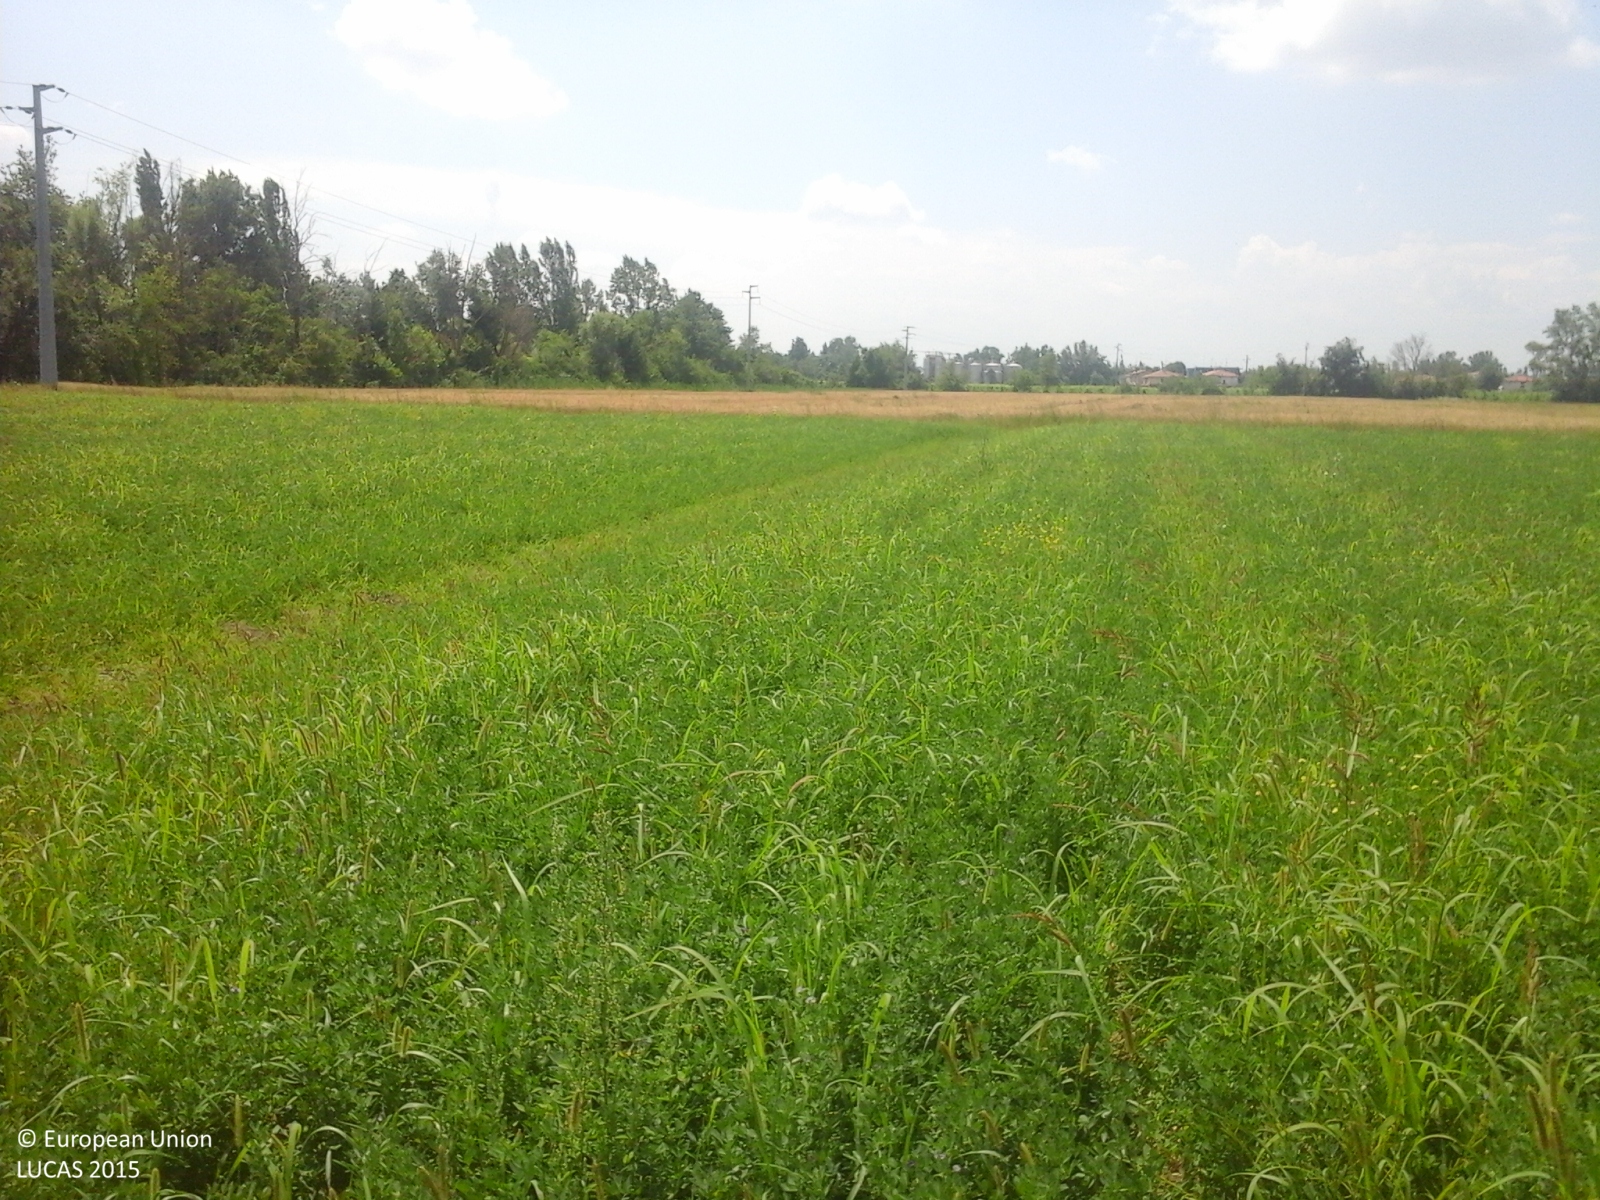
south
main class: Cropland
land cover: Lucerne
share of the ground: > 75 %
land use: Agriculture (excluding fallow land and kitchen gardens)
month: June
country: IT
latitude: 44.8154
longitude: 10.9212
